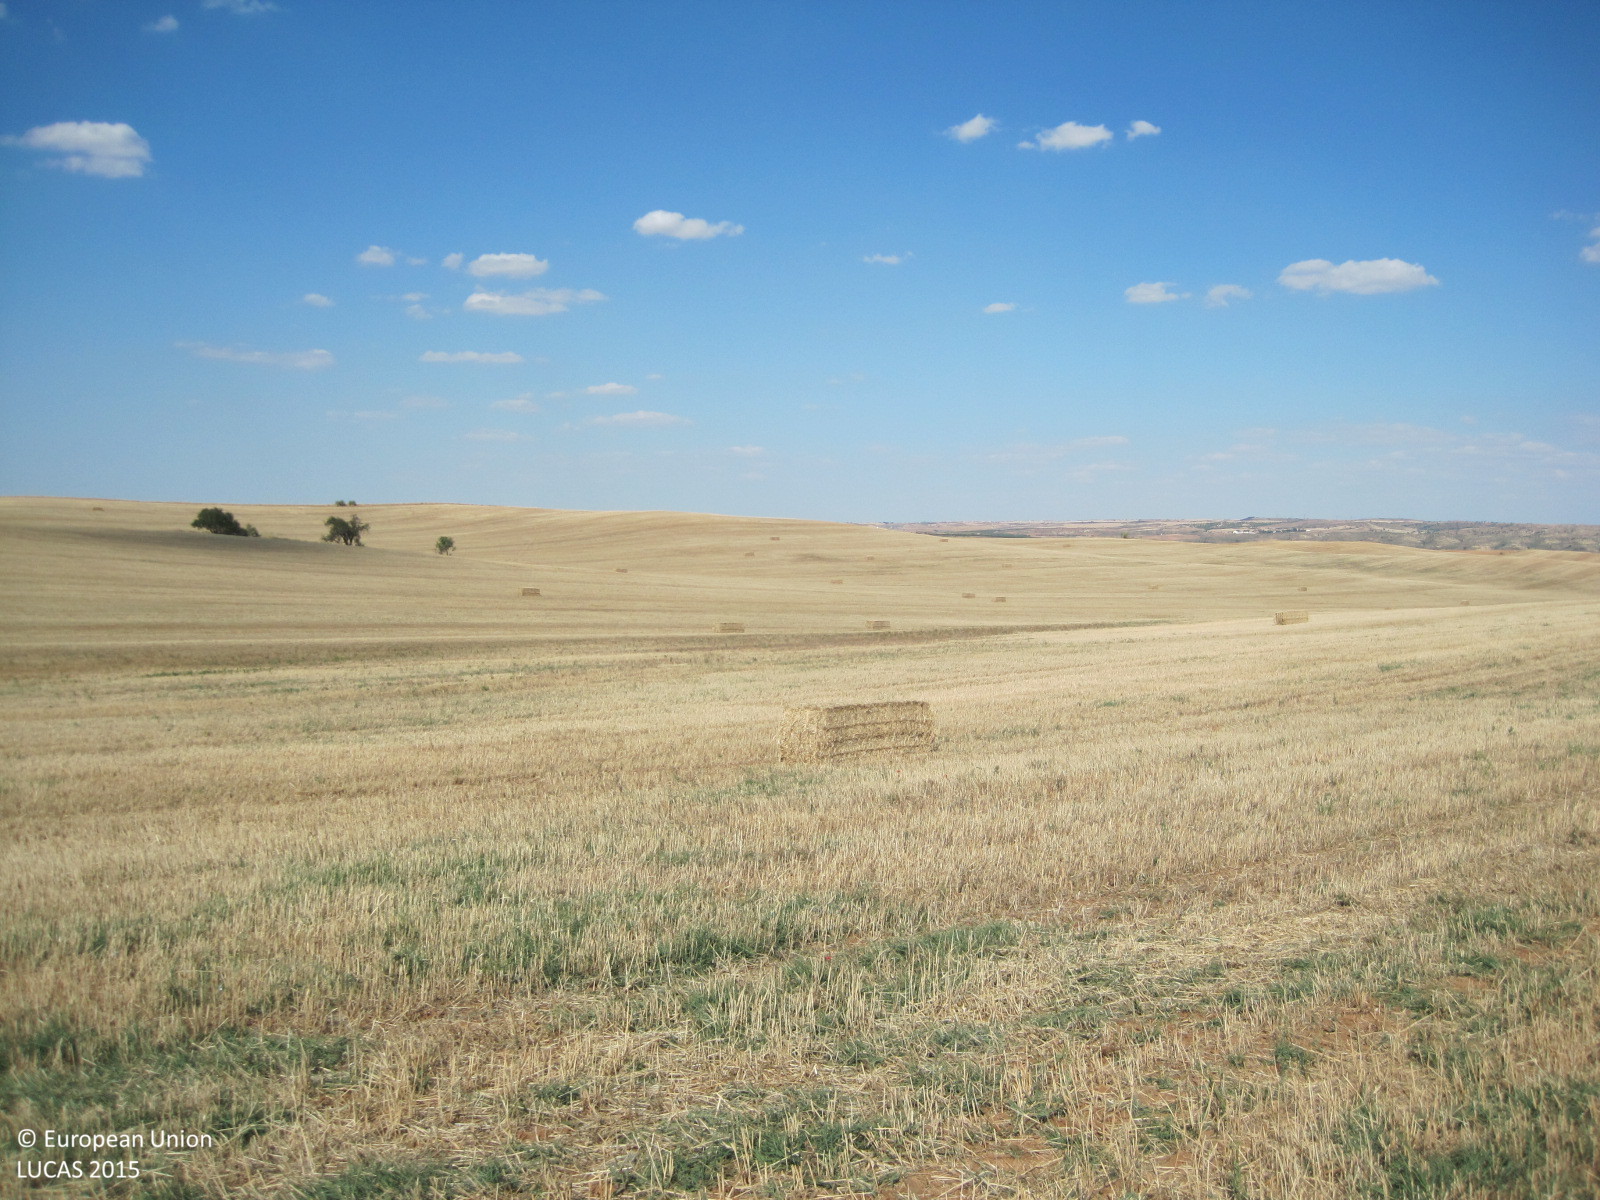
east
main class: Cropland
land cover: Barley
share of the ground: < 10 %
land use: Agriculture (excluding fallow land and kitchen gardens)
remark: Harvested field
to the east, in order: Barley
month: June
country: ES
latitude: 39.9245
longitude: -4.2070
